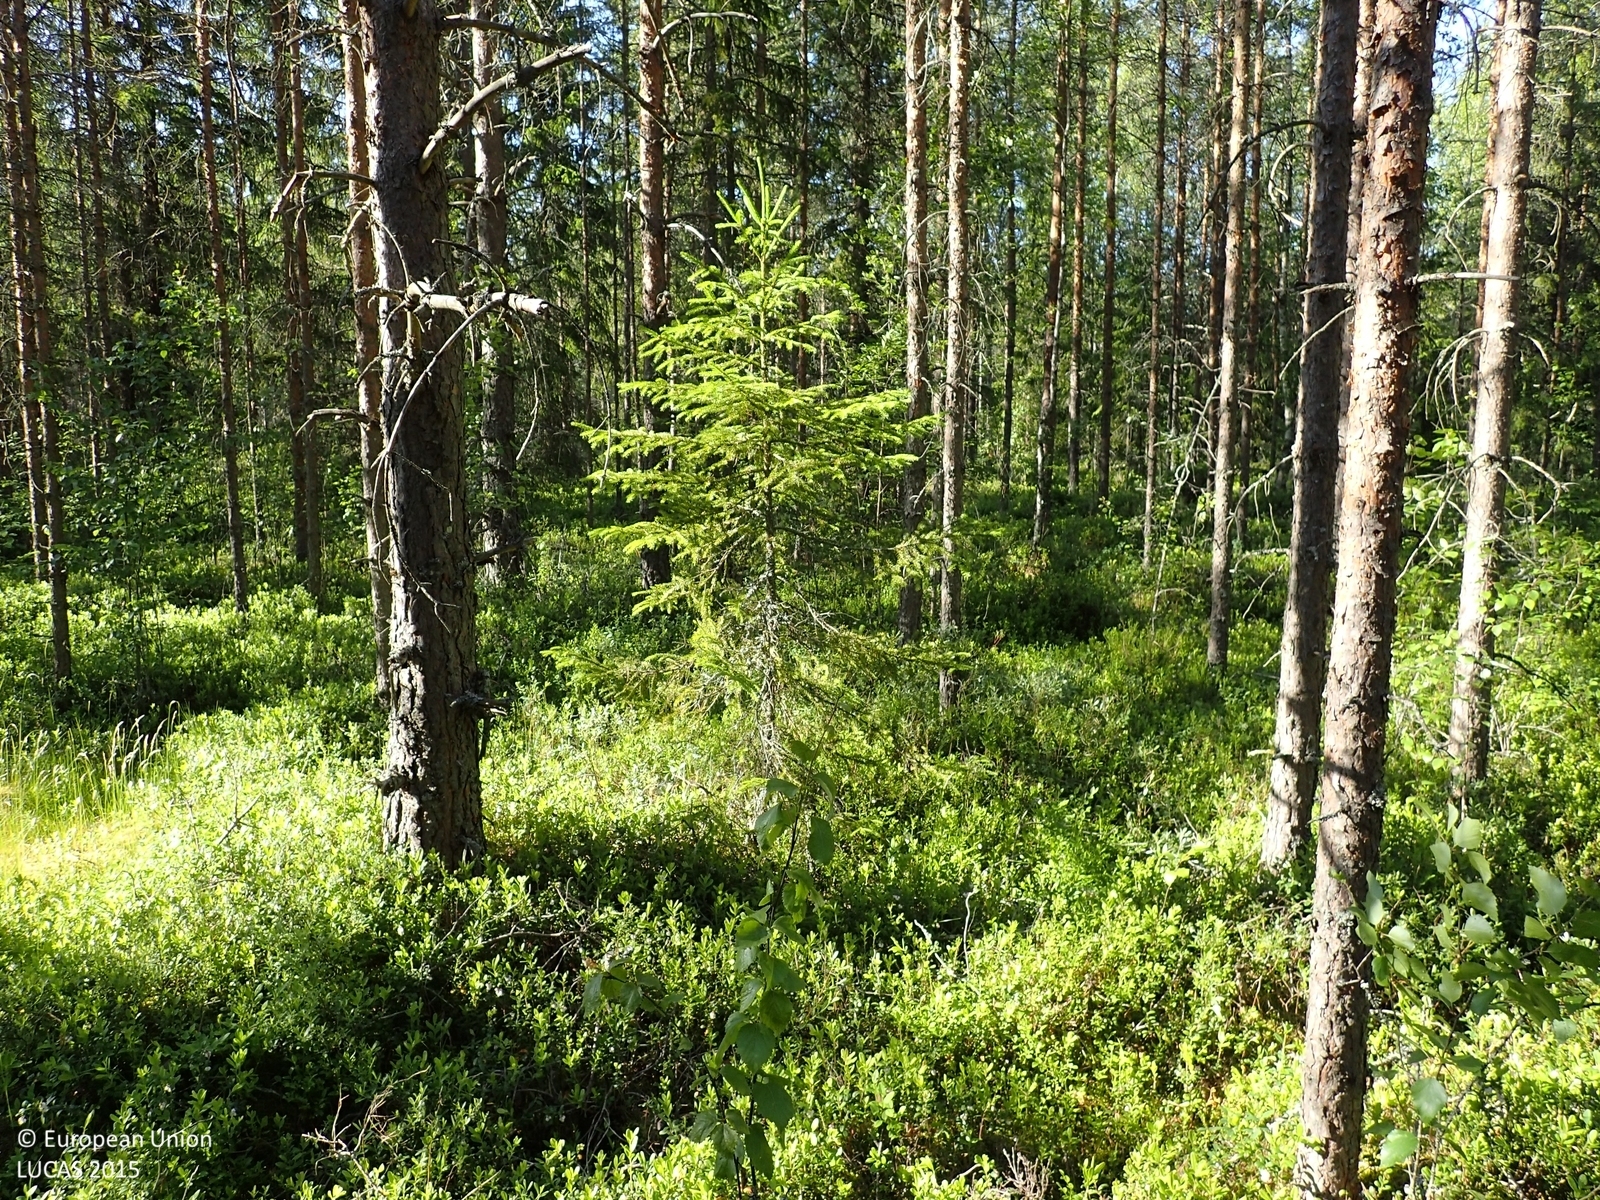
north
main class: Woodland
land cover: Pine dominated coniferous woodland
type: boreal forest
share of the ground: 50 - 75 %
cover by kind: coniferous forest trees 50 %, shrubs 45 %, broadleaved forest trees 5 %
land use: Forestry
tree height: > 5 m
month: July
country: FI
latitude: 62.7046
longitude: 21.6739
